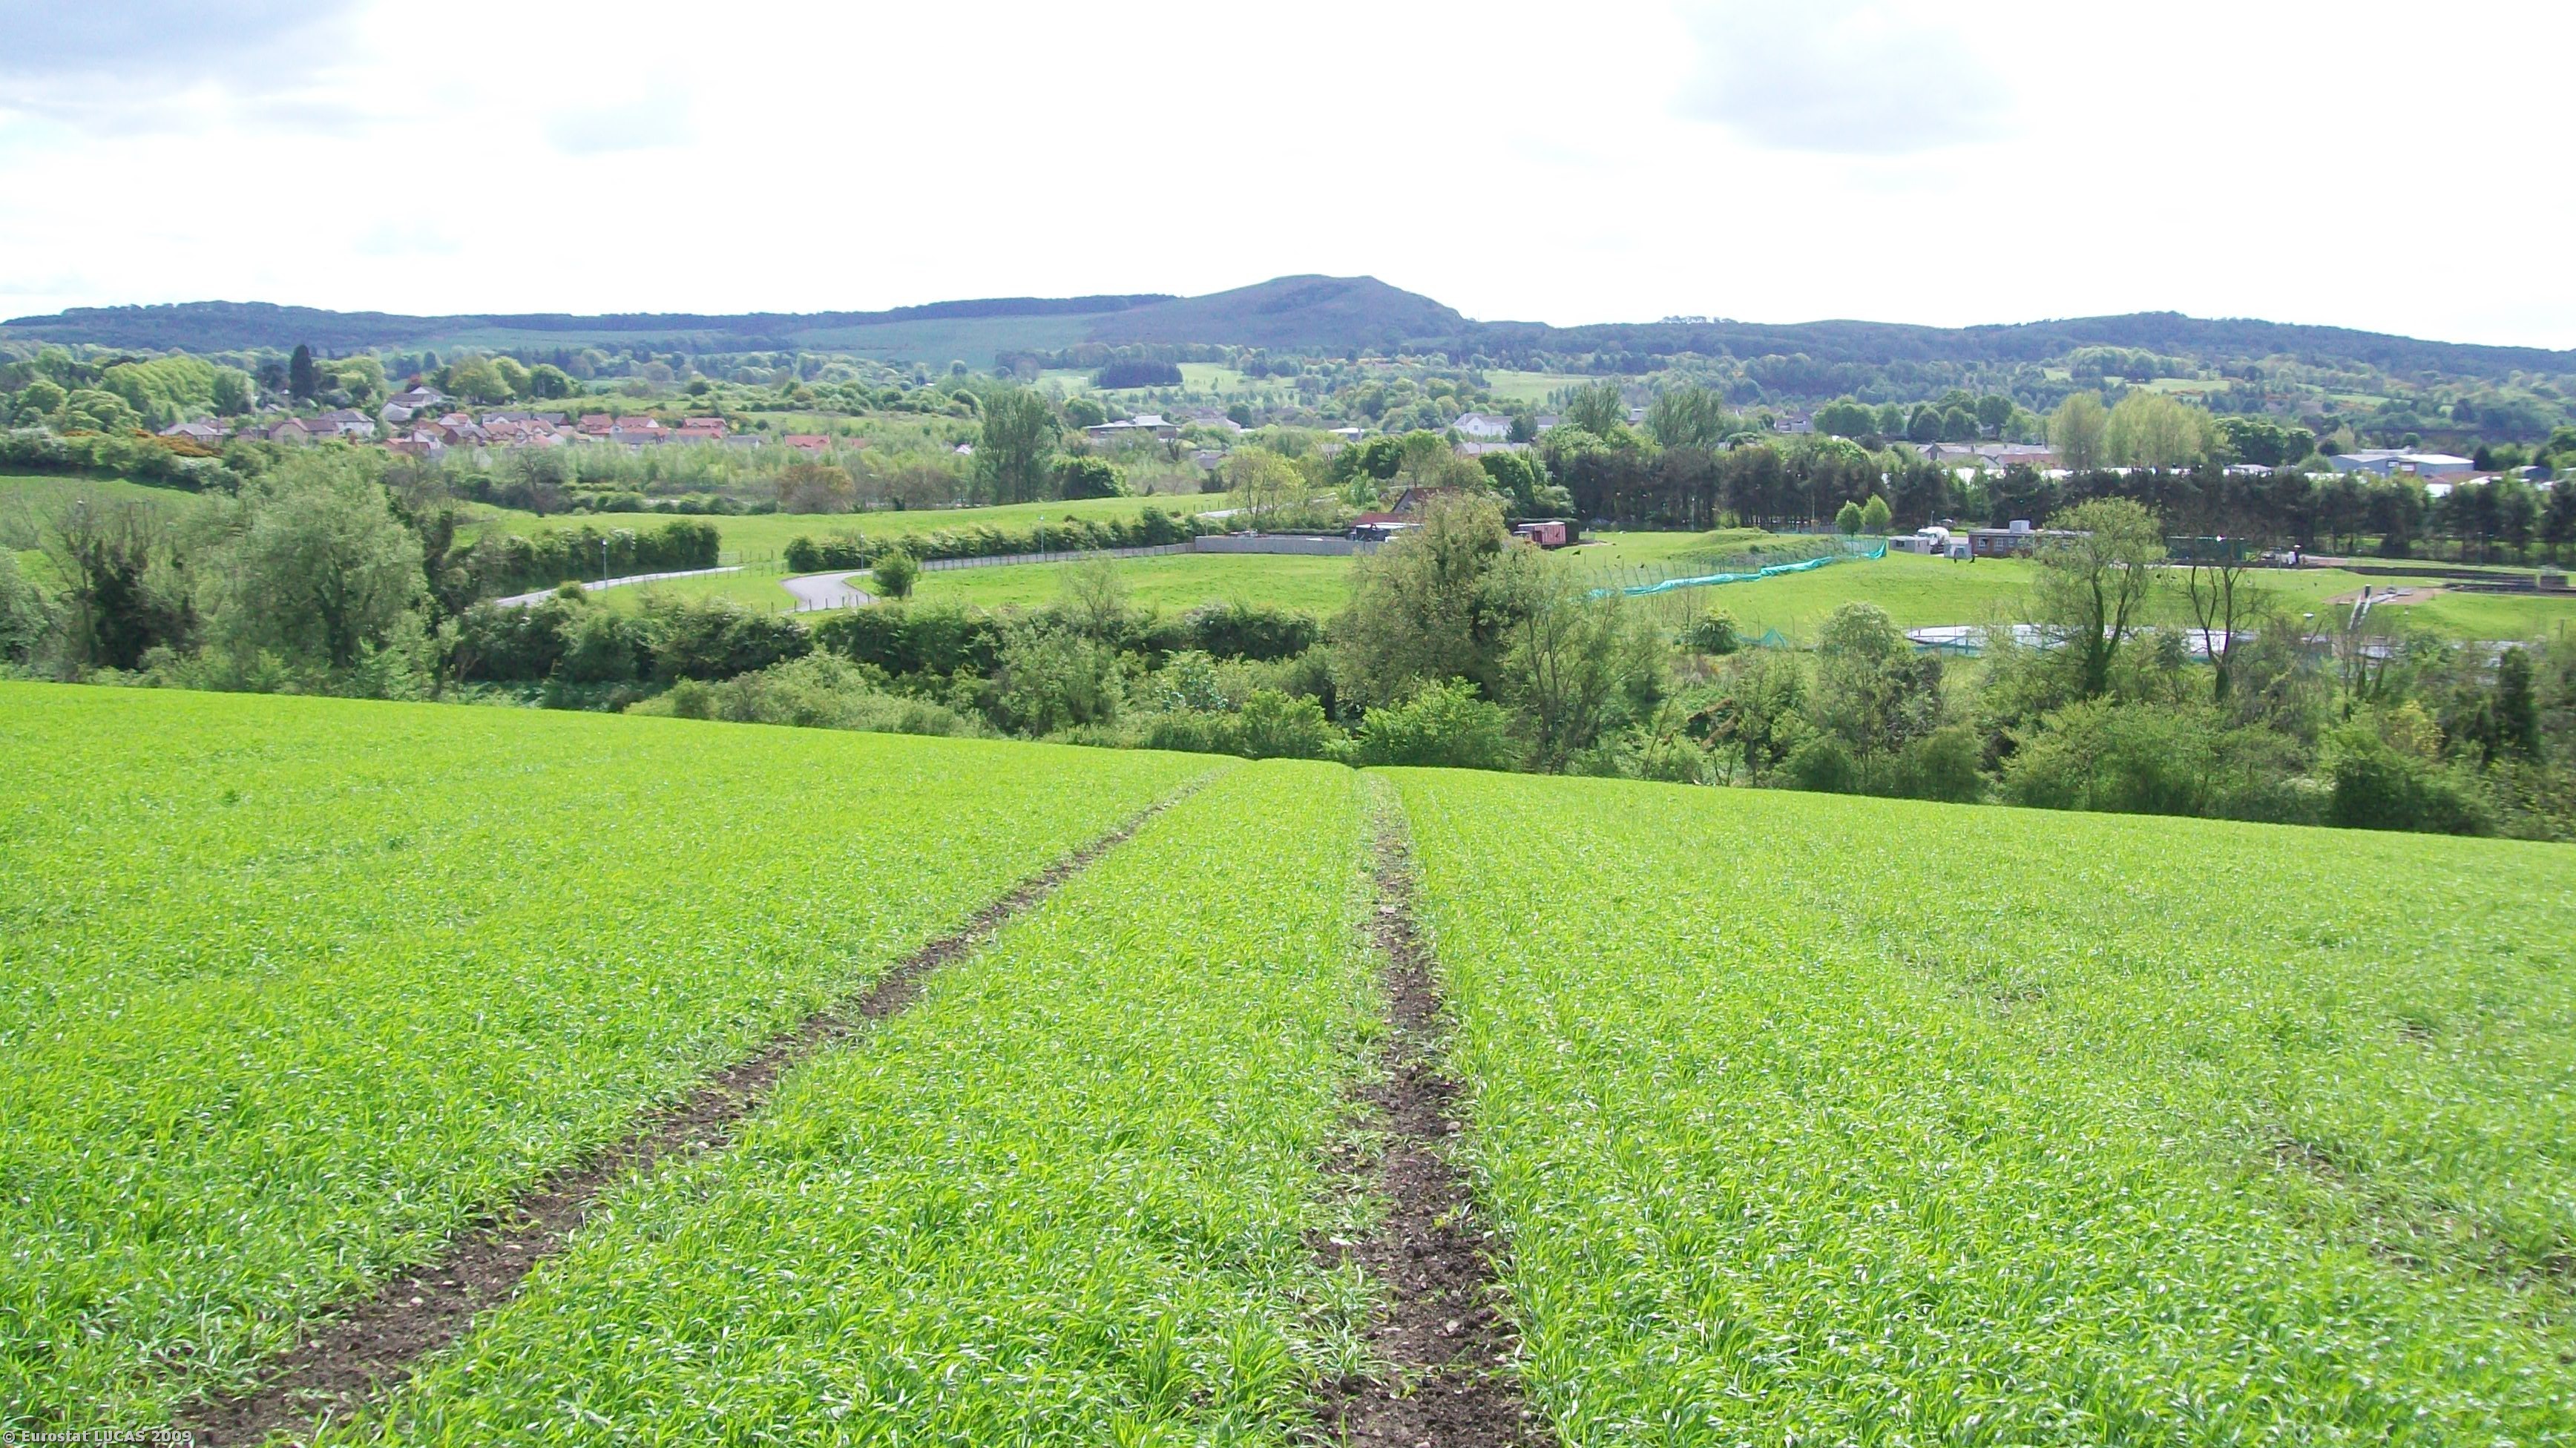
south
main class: Cropland
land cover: Barley
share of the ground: > 75 %
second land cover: Rape and turnip rape
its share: 50 - 75 %
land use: Agriculture (excluding fallow land and kitchen gardens)
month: May
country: GB
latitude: 55.9862
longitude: -3.6242
